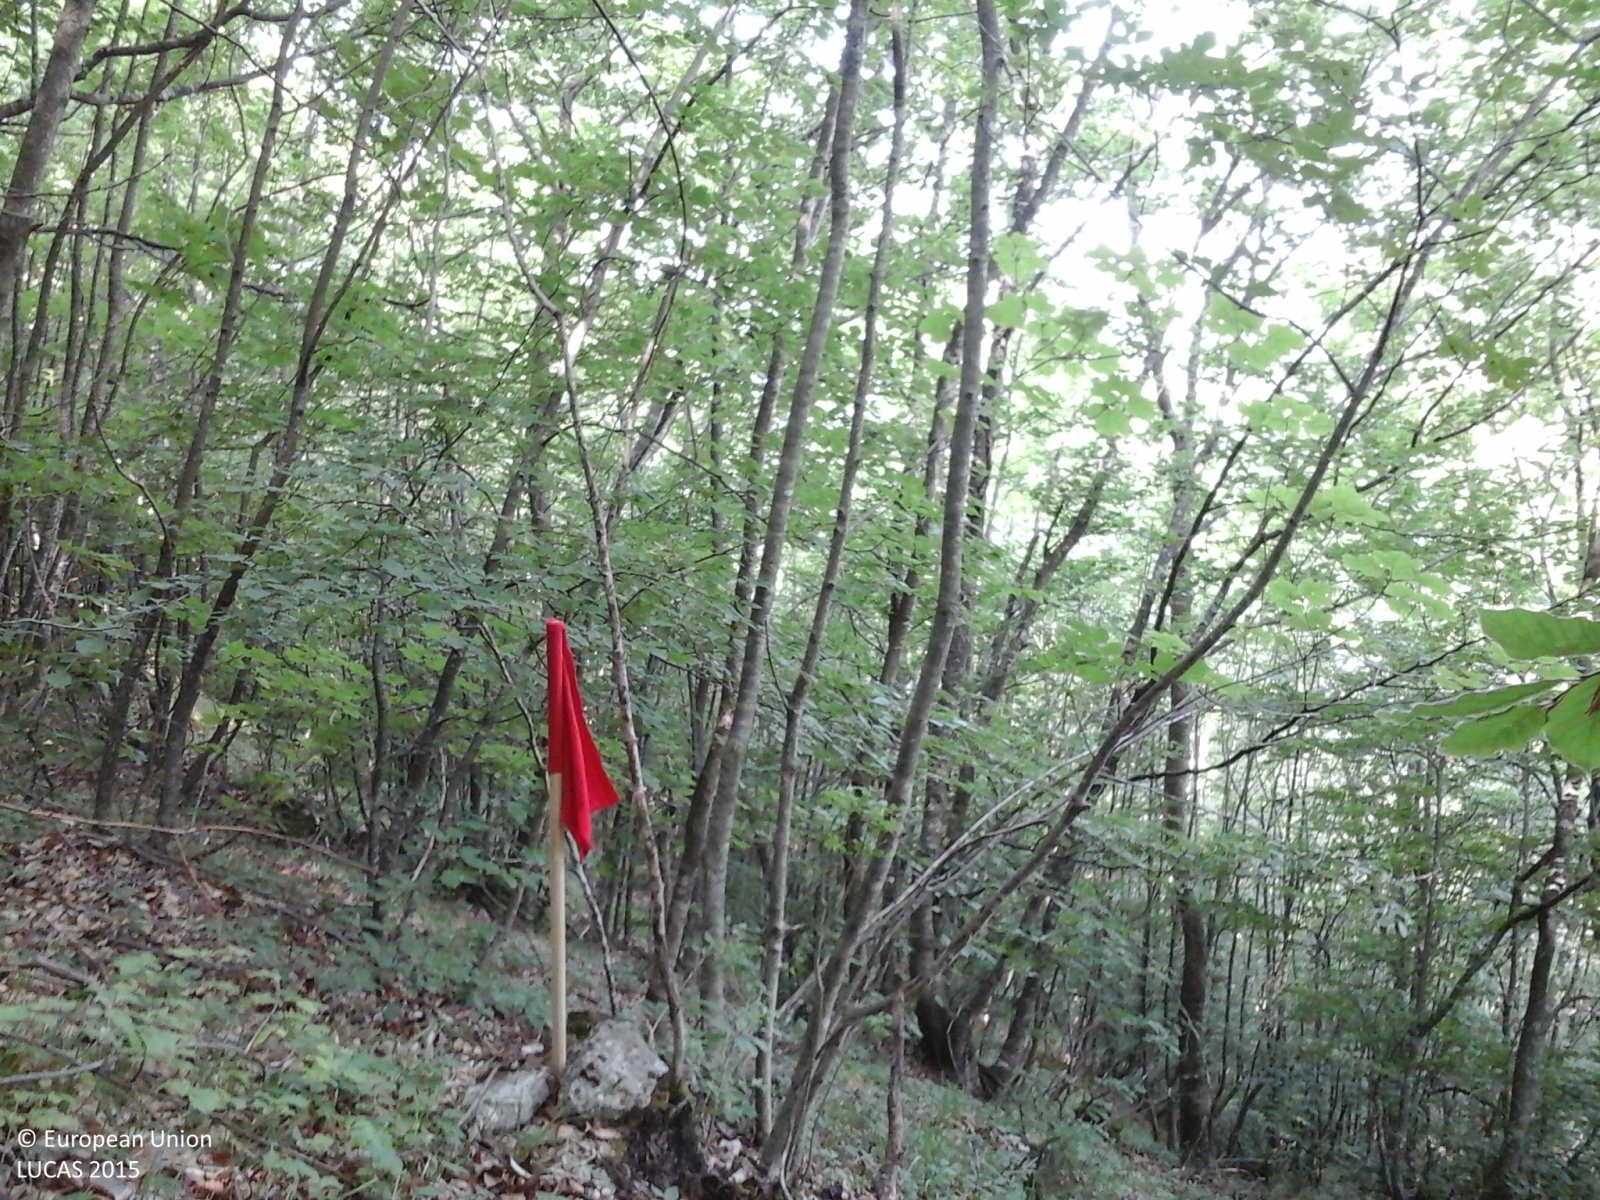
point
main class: Woodland
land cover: Broadleaved woodland
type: mountainous beech forest
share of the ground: > 75 %
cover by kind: broadleaved forest trees 95 %, herbaceous plants 5 %
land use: Forestry
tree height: > 5 m
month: May
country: IT
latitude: 41.7655
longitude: 13.3917
